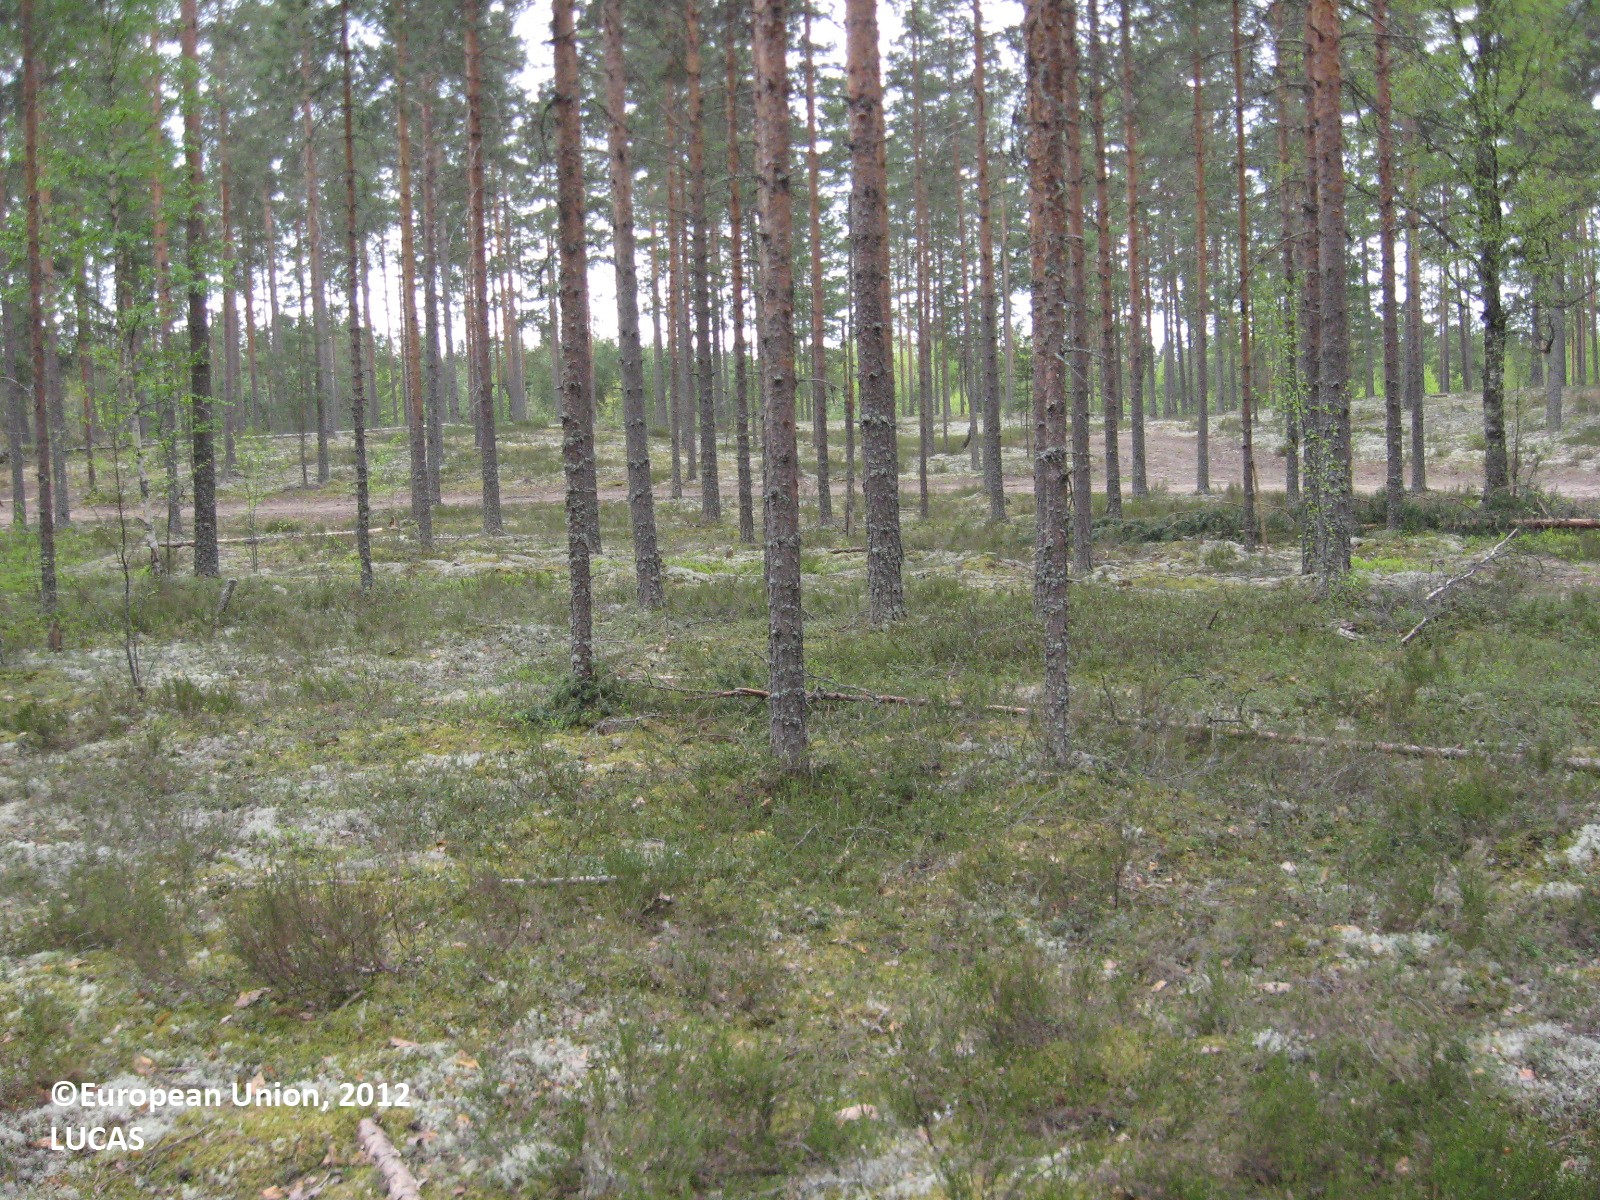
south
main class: Woodland
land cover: Pine dominated coniferous woodland
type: boreal forest
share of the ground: 50 - 75 %
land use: Community services
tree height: > 5 m
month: May
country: FI
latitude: 61.7640
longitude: 22.6639
